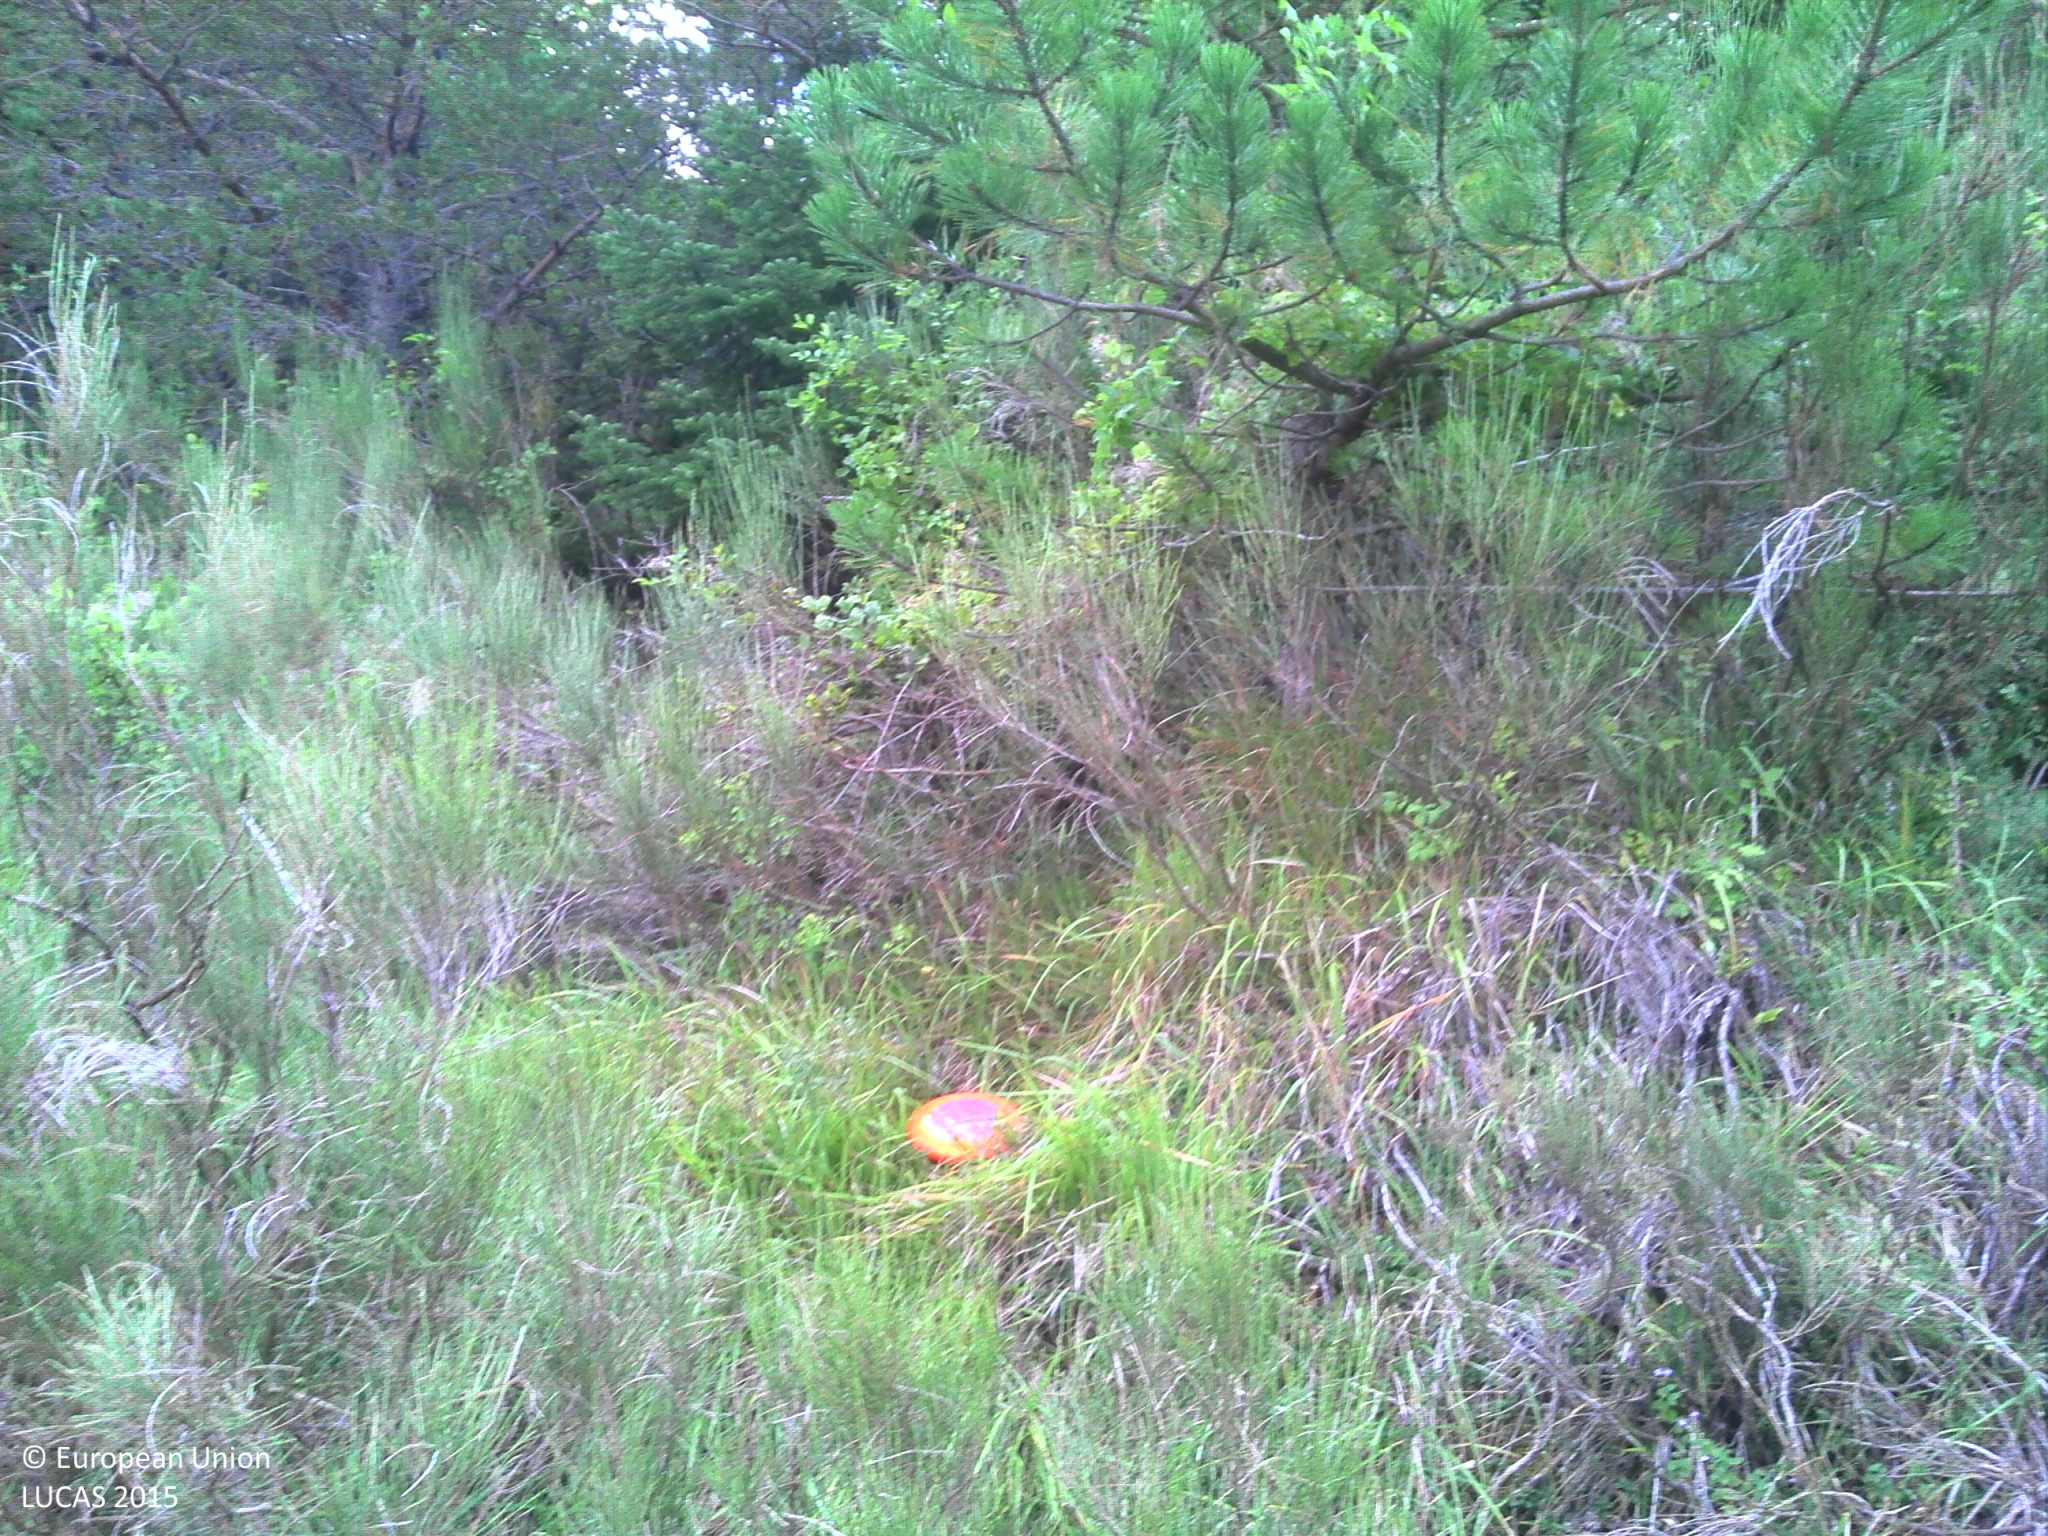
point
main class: Woodland
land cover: Pine dominated coniferous woodland
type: alpine coniferous forest
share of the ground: > 75 %
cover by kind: coniferous forest trees 75 %, shrubs 10 %, broadleaved forest trees 5 %, herbaceous plants 5 %, consolidated bare surface 5 %
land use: Forestry
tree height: > 5 m
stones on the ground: < 10 %
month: September
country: FR
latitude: 44.4367
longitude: 5.5723
